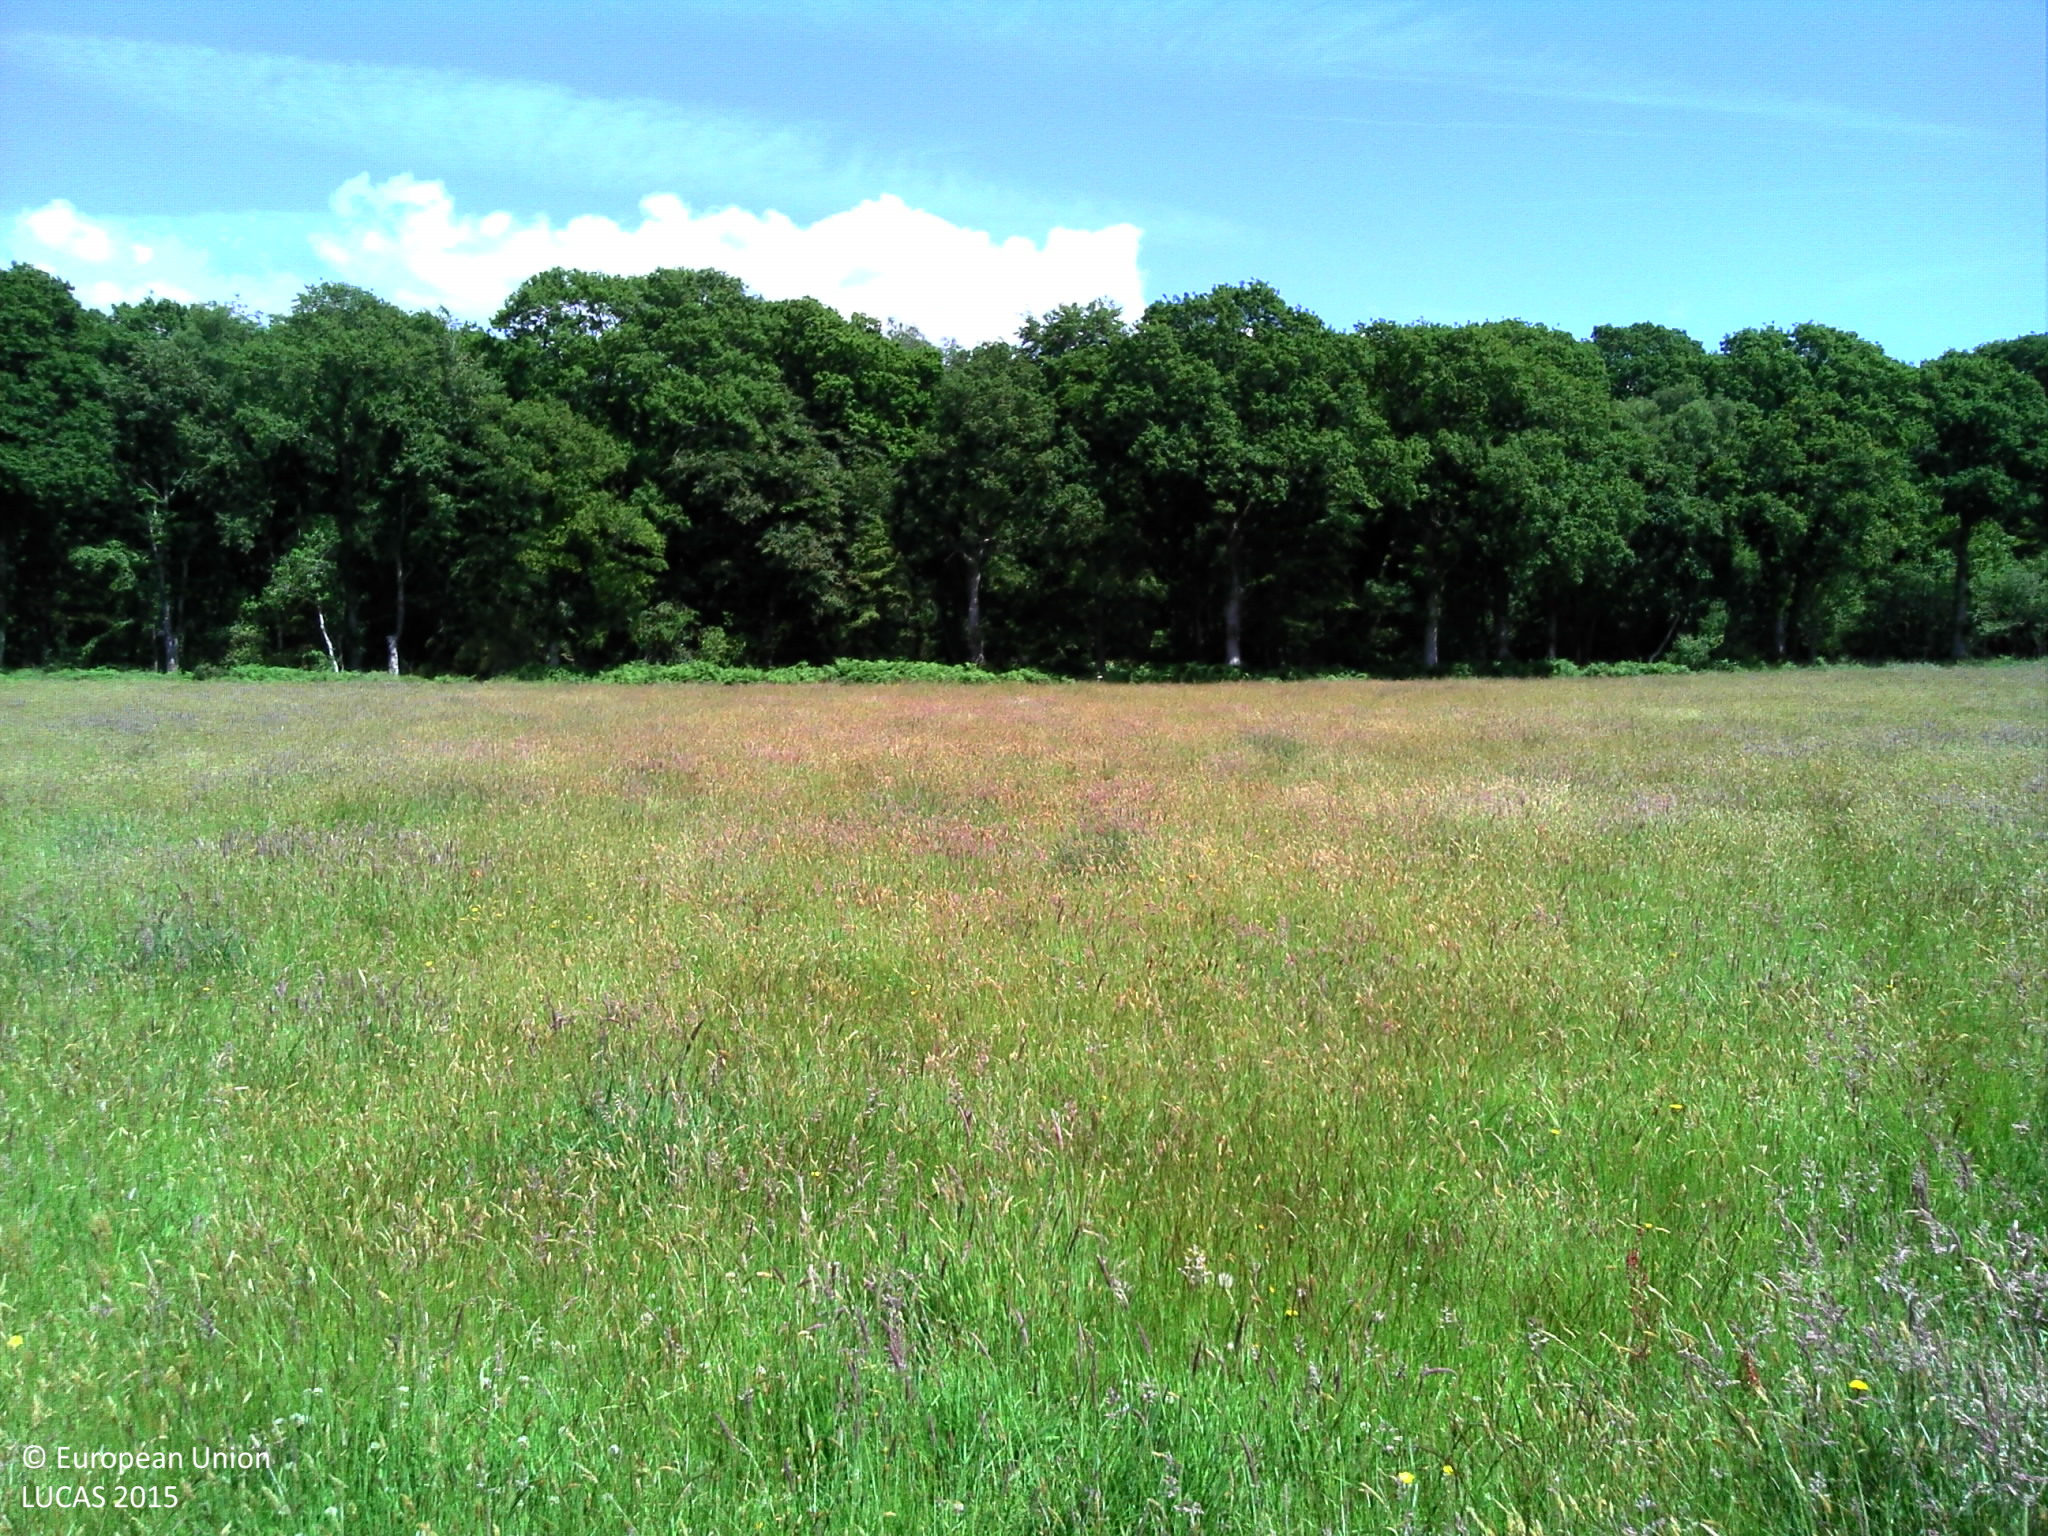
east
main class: Grassland
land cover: Grassland without tree/shrub cover
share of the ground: > 75 %
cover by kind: herbaceous plants 100 %
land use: Agriculture (excluding fallow land and kitchen gardens)
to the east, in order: Grassland without tree/shrub cover; Rivers and streams; Broadleaved woodland
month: June
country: FR
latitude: 49.3088
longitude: -1.5065
